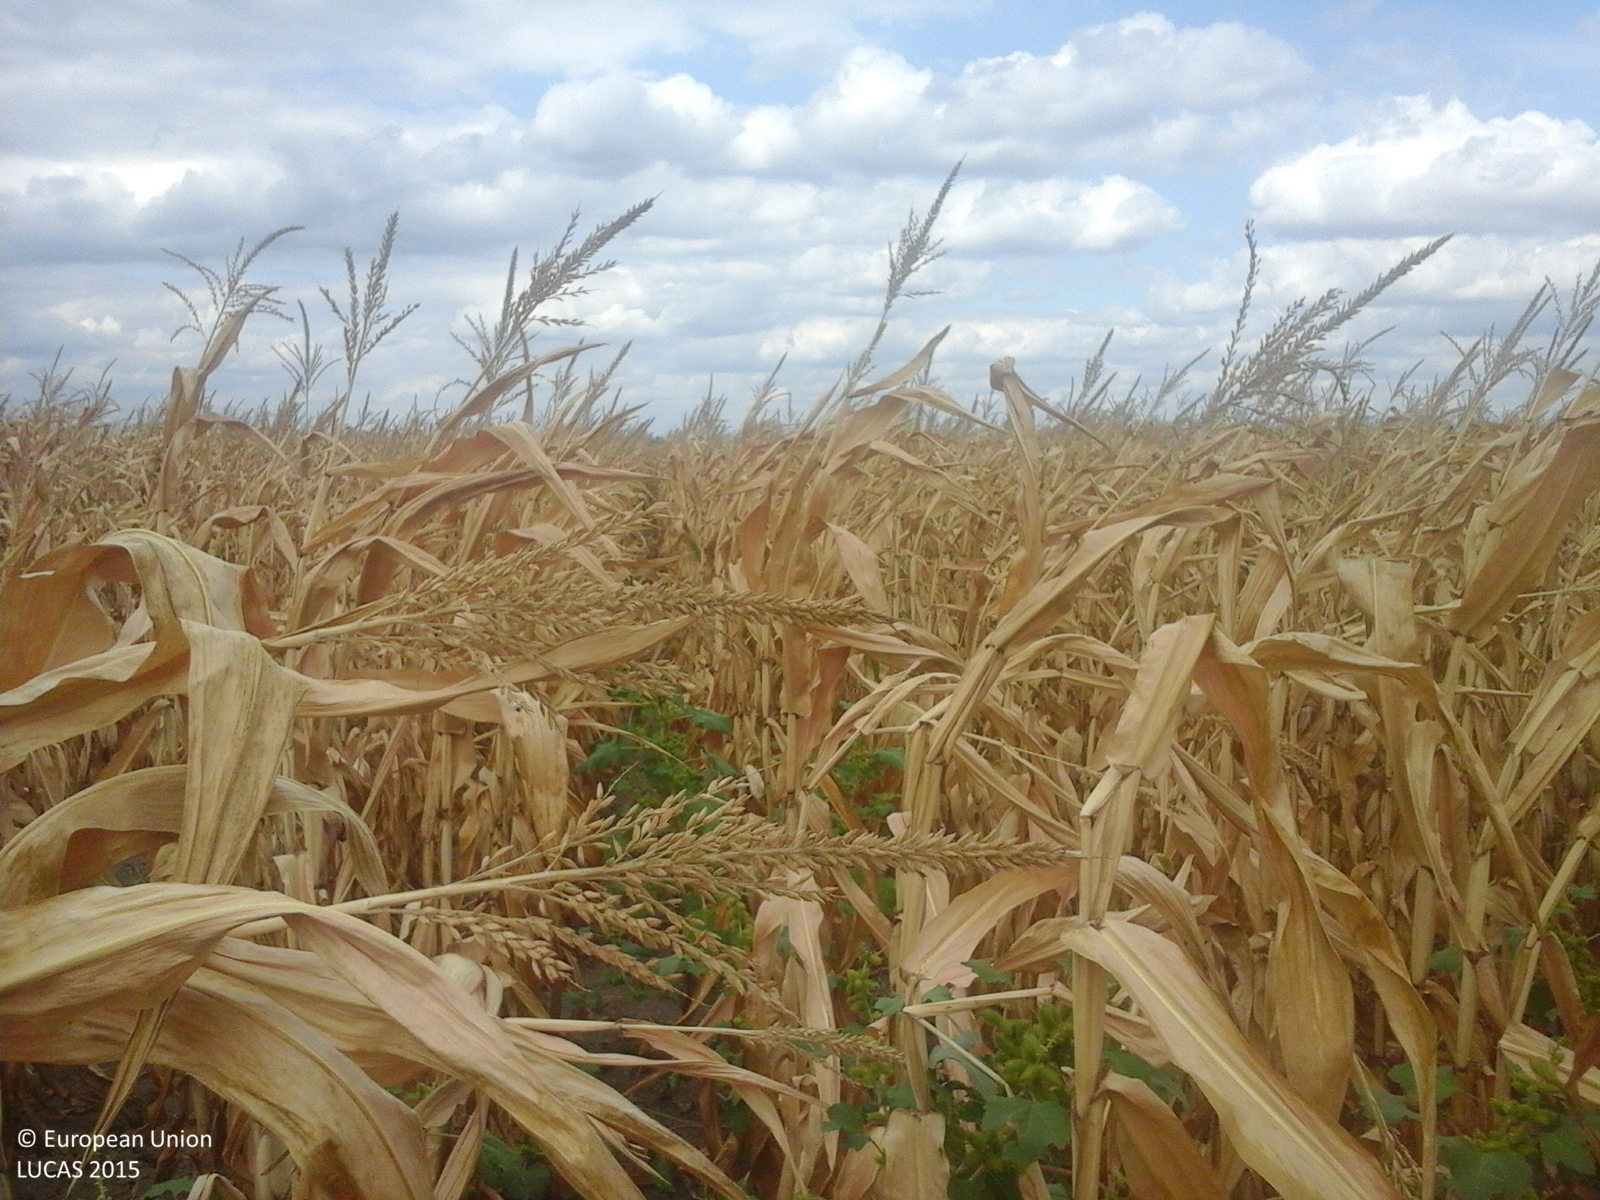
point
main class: Cropland
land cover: Maize
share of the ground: > 75 %
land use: Agriculture (excluding fallow land and kitchen gardens)
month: September
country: RO
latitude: 47.8853
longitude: 22.8629
